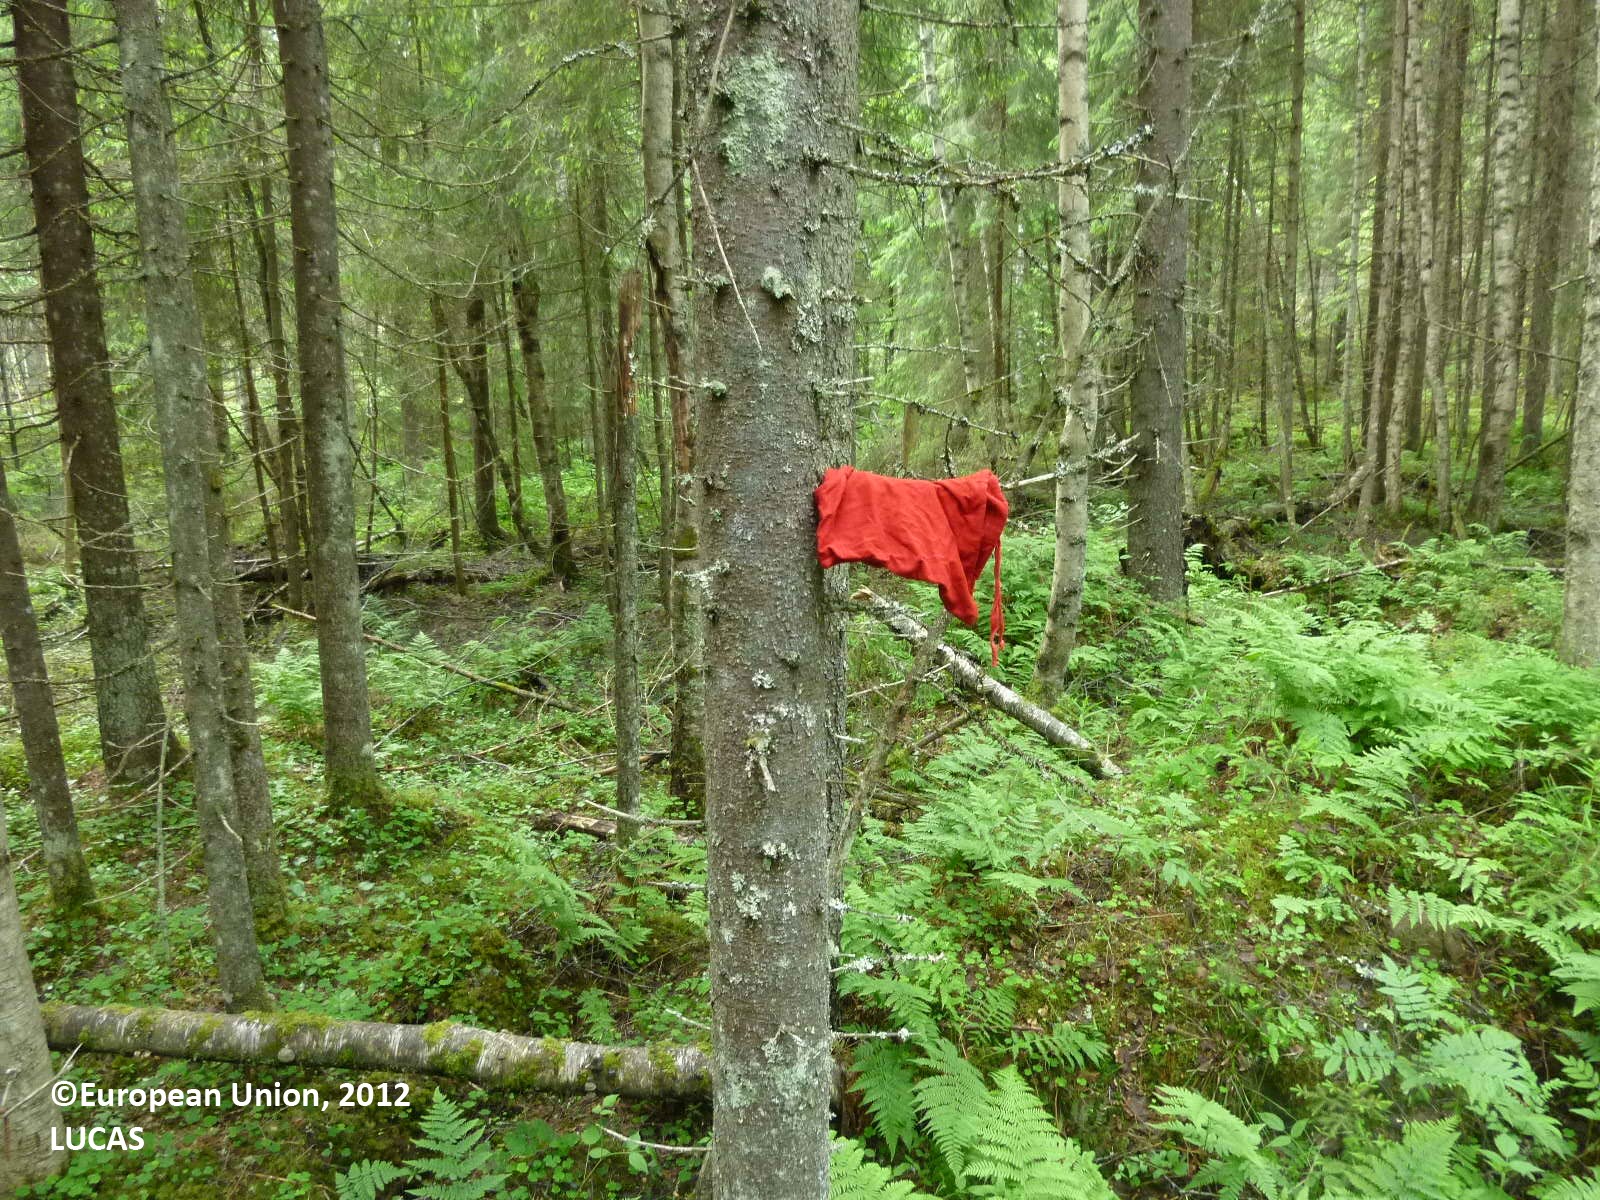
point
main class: Woodland
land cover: Spruce dominated mixed woodland
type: boreal forest
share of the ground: > 75 %
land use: Forestry
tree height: > 5 m
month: June
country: FI
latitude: 61.6979
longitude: 22.3685
